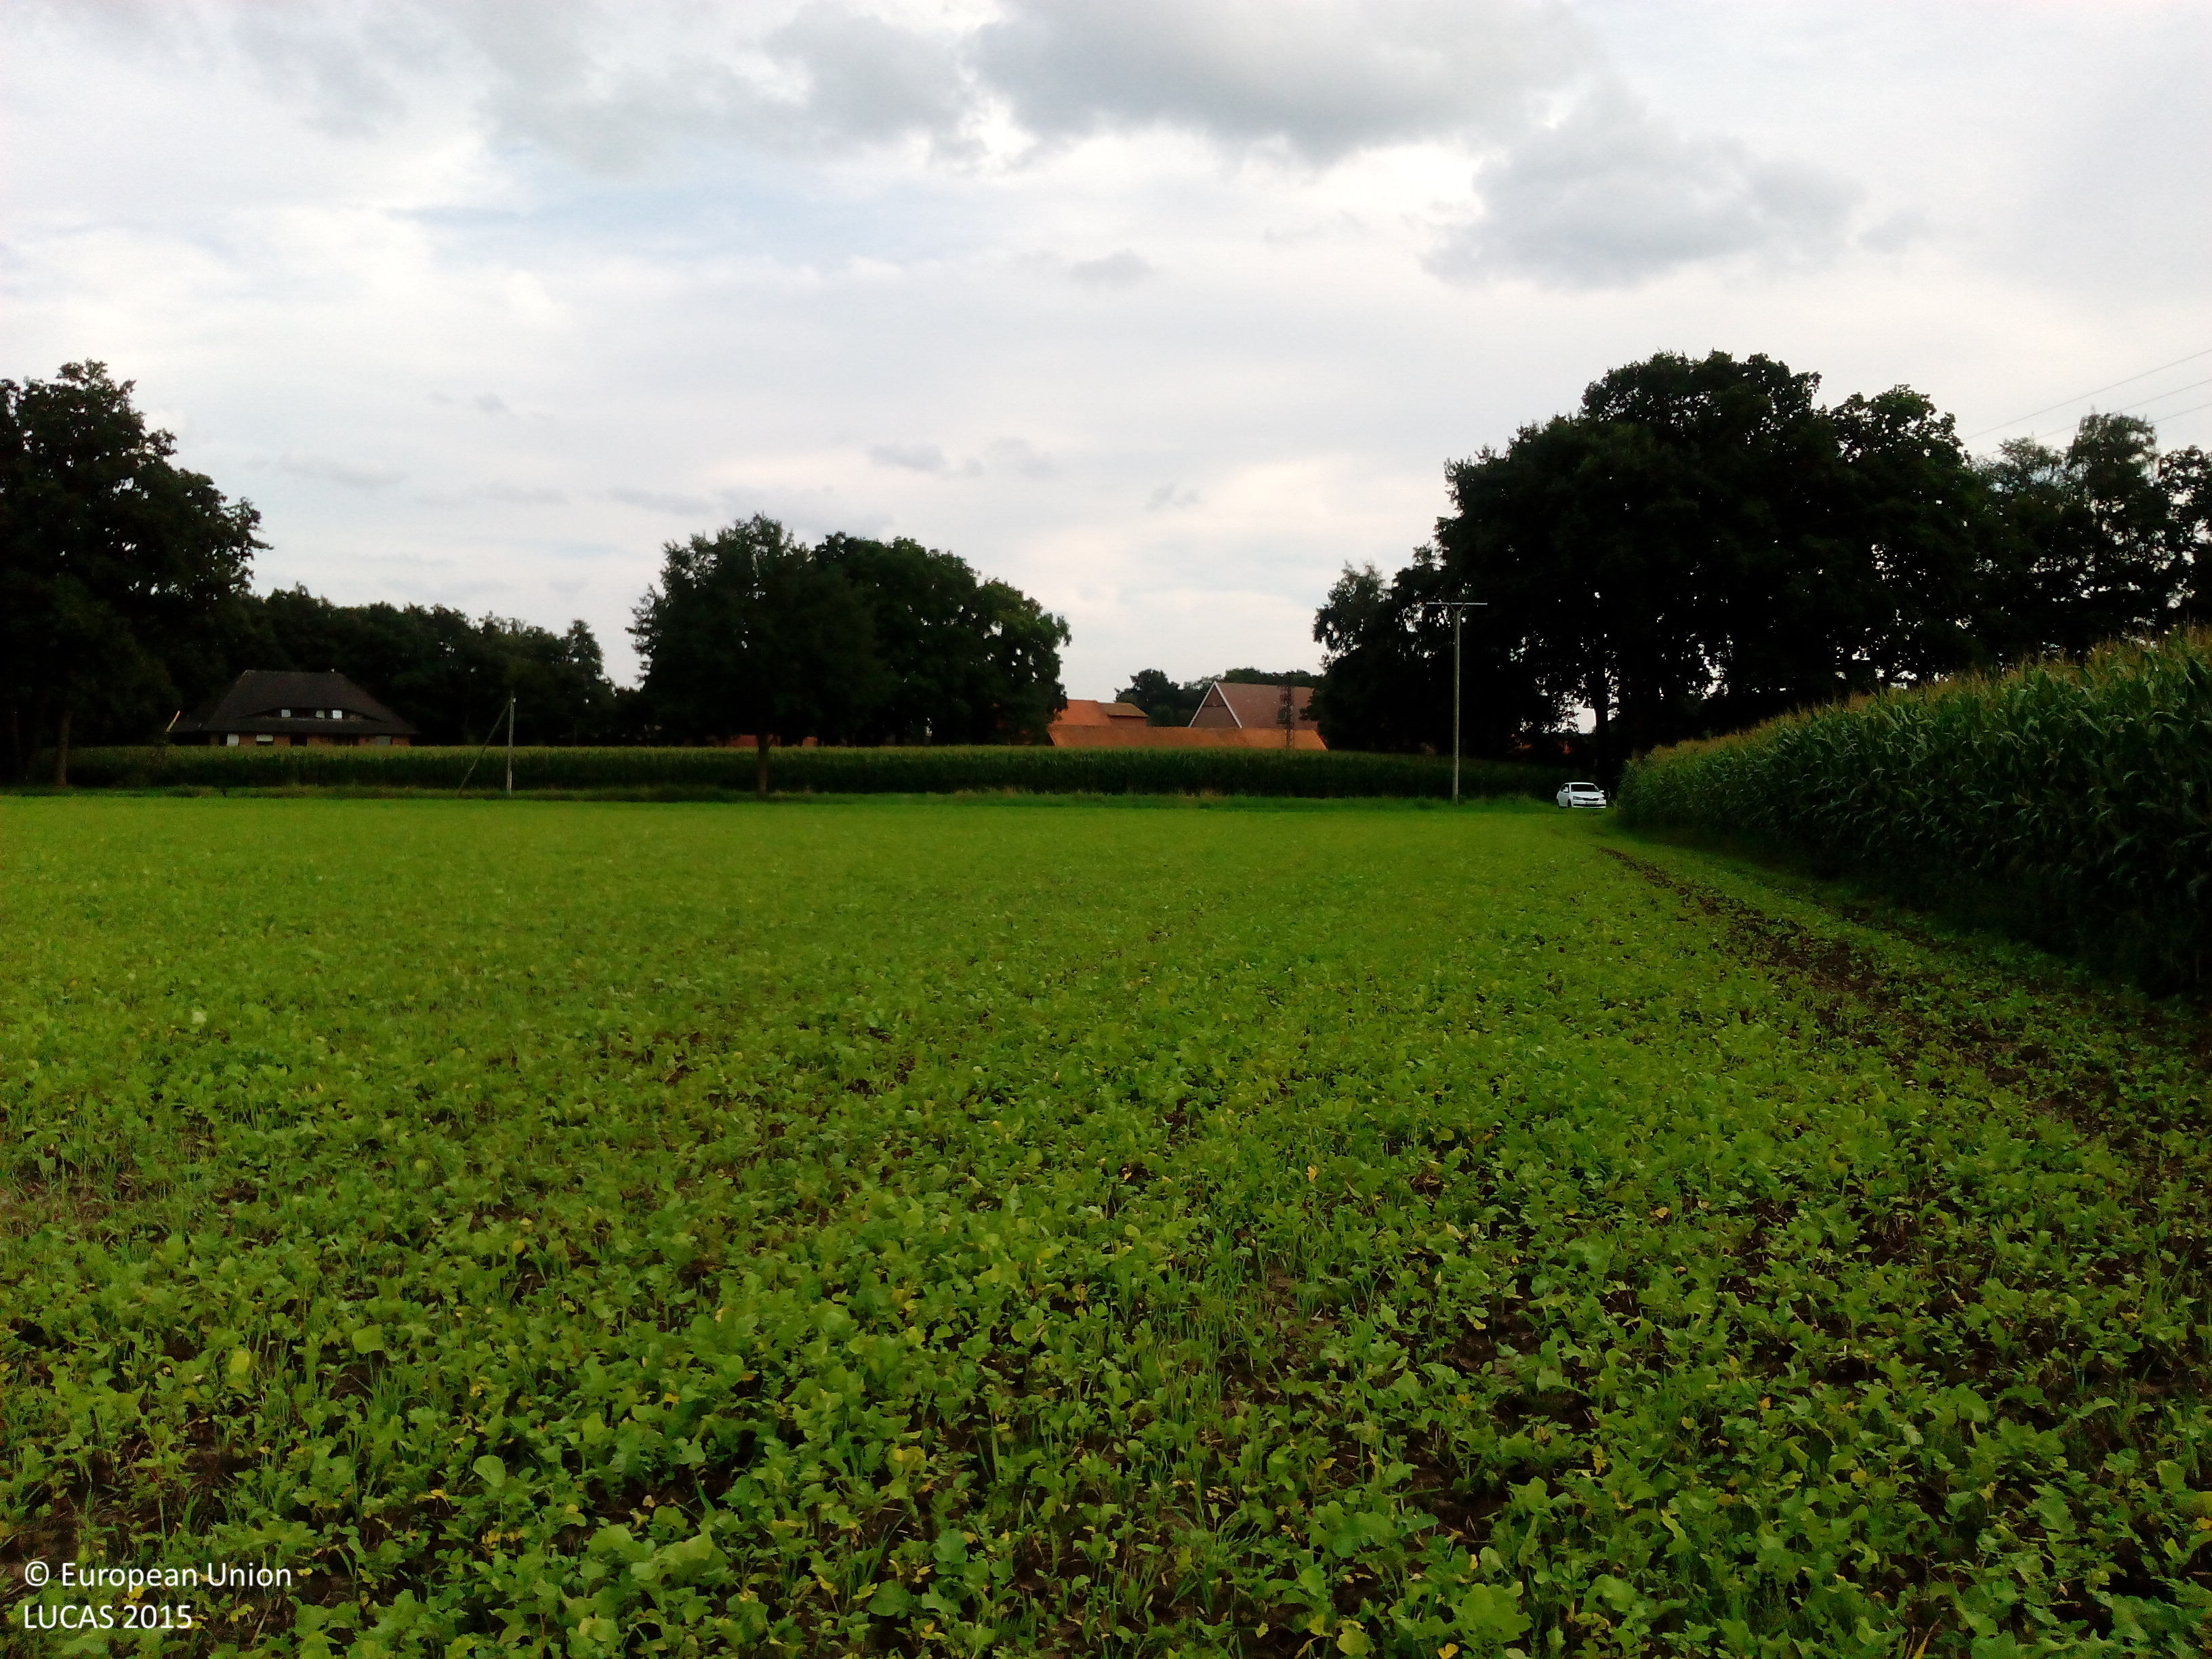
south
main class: Grassland
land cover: Spontaneously vegetated surfaces
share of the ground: > 75 %
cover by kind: herbaceous plants 100 %
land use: Agriculture (excluding fallow land and kitchen gardens)
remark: Harvested field
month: August
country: DE
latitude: 52.4328
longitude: 8.0149
